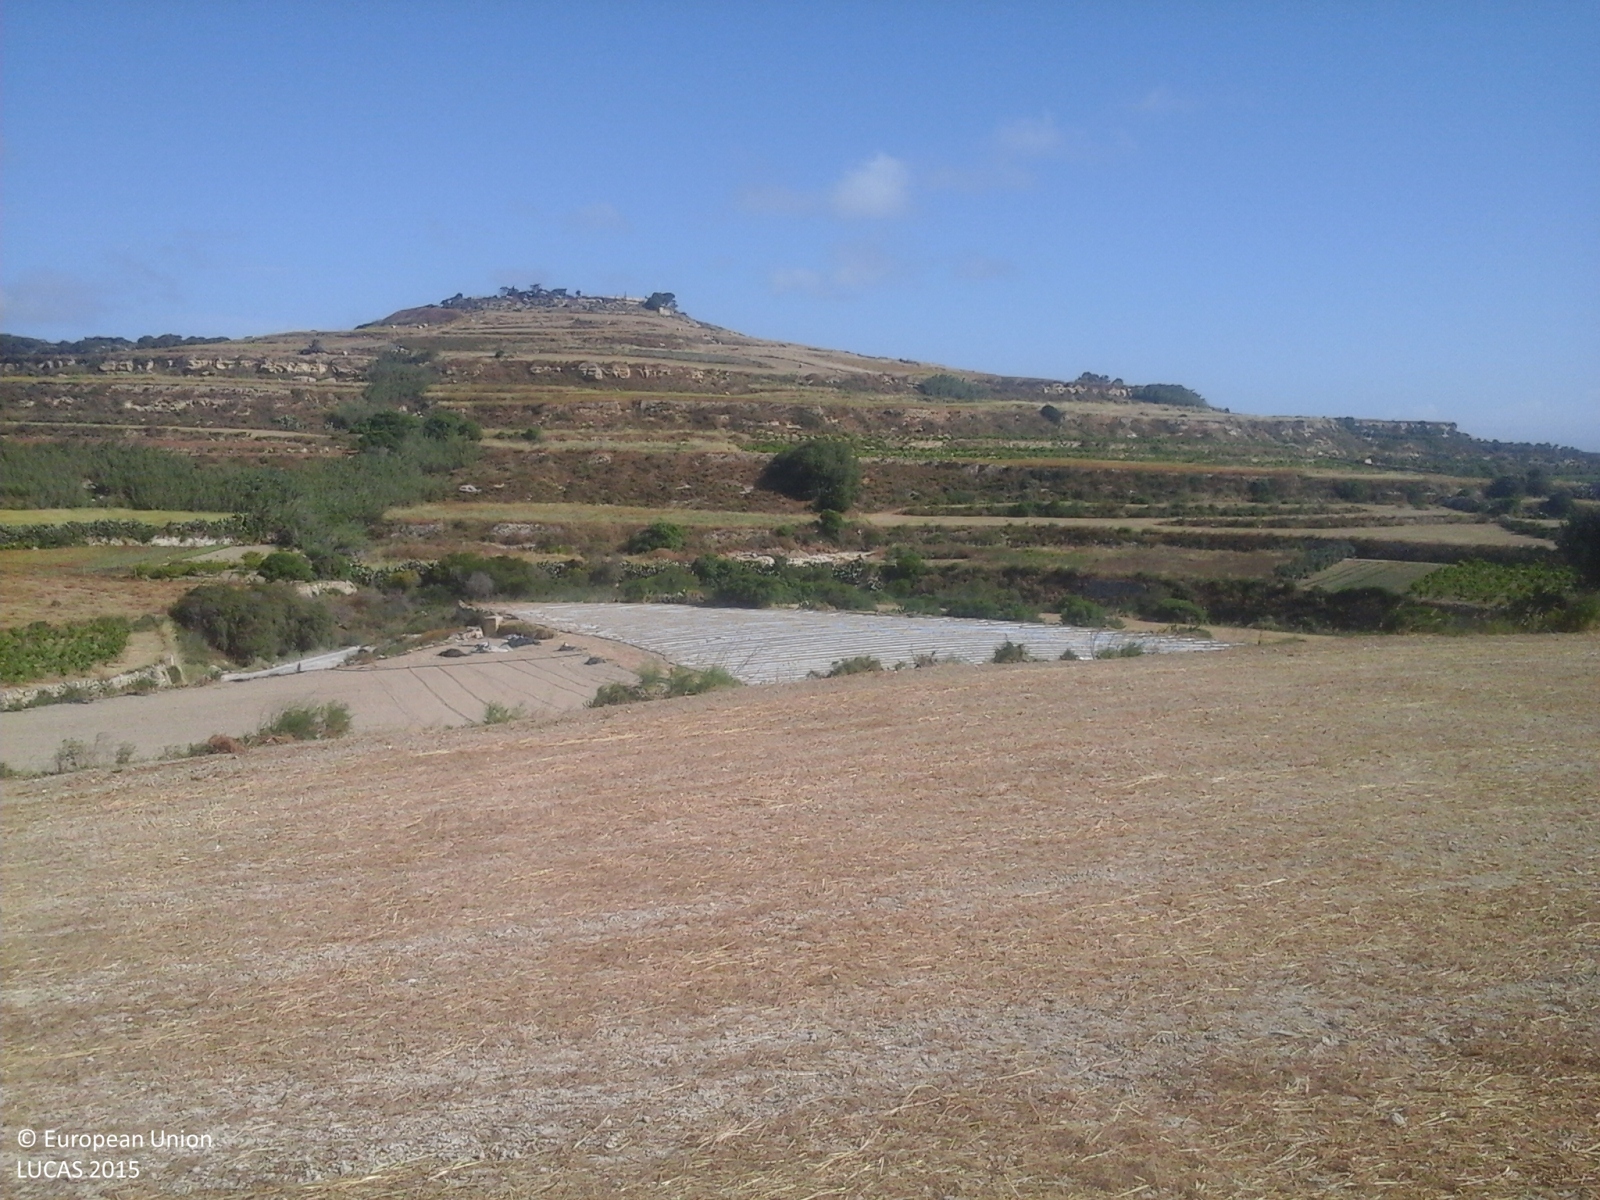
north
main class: Cropland
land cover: Mixed cereals for fodder
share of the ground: > 75 %
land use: Agriculture (excluding fallow land and kitchen gardens)
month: May
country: MT
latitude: 35.8987
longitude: 14.4021
